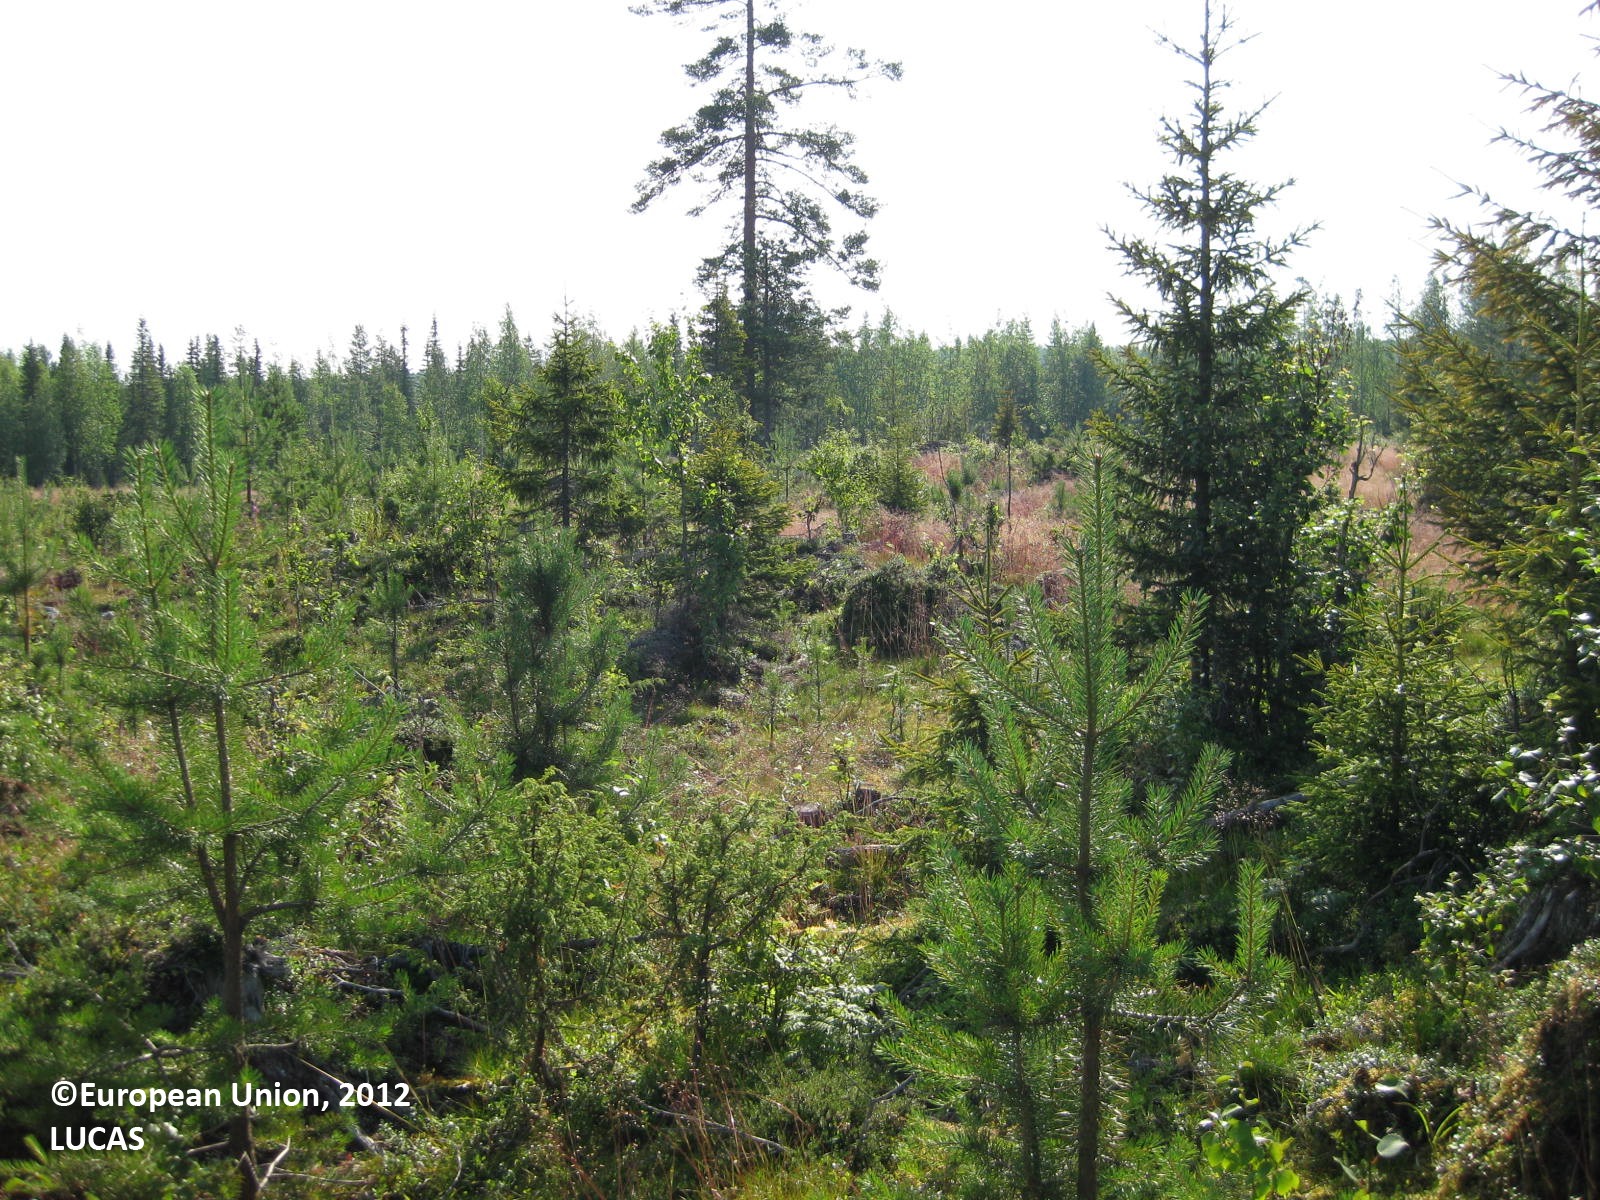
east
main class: Woodland
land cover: Pine dominated mixed woodland
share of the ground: 25 - 50 %
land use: Forestry
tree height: < 5 m
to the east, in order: Pine dominated mixed woodland; Spontaneously vegetated surfaces; Spruce dominated mixed woodland; Spontaneously vegetated surfaces; Paved roads, cycling and walking lanes; Spontaneously vegetated surfaces; Spruce dominated mixed woodland; Other mixed woodland; Spruce dominated mixed woodland
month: July
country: FI
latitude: 65.8293
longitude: 28.5659
